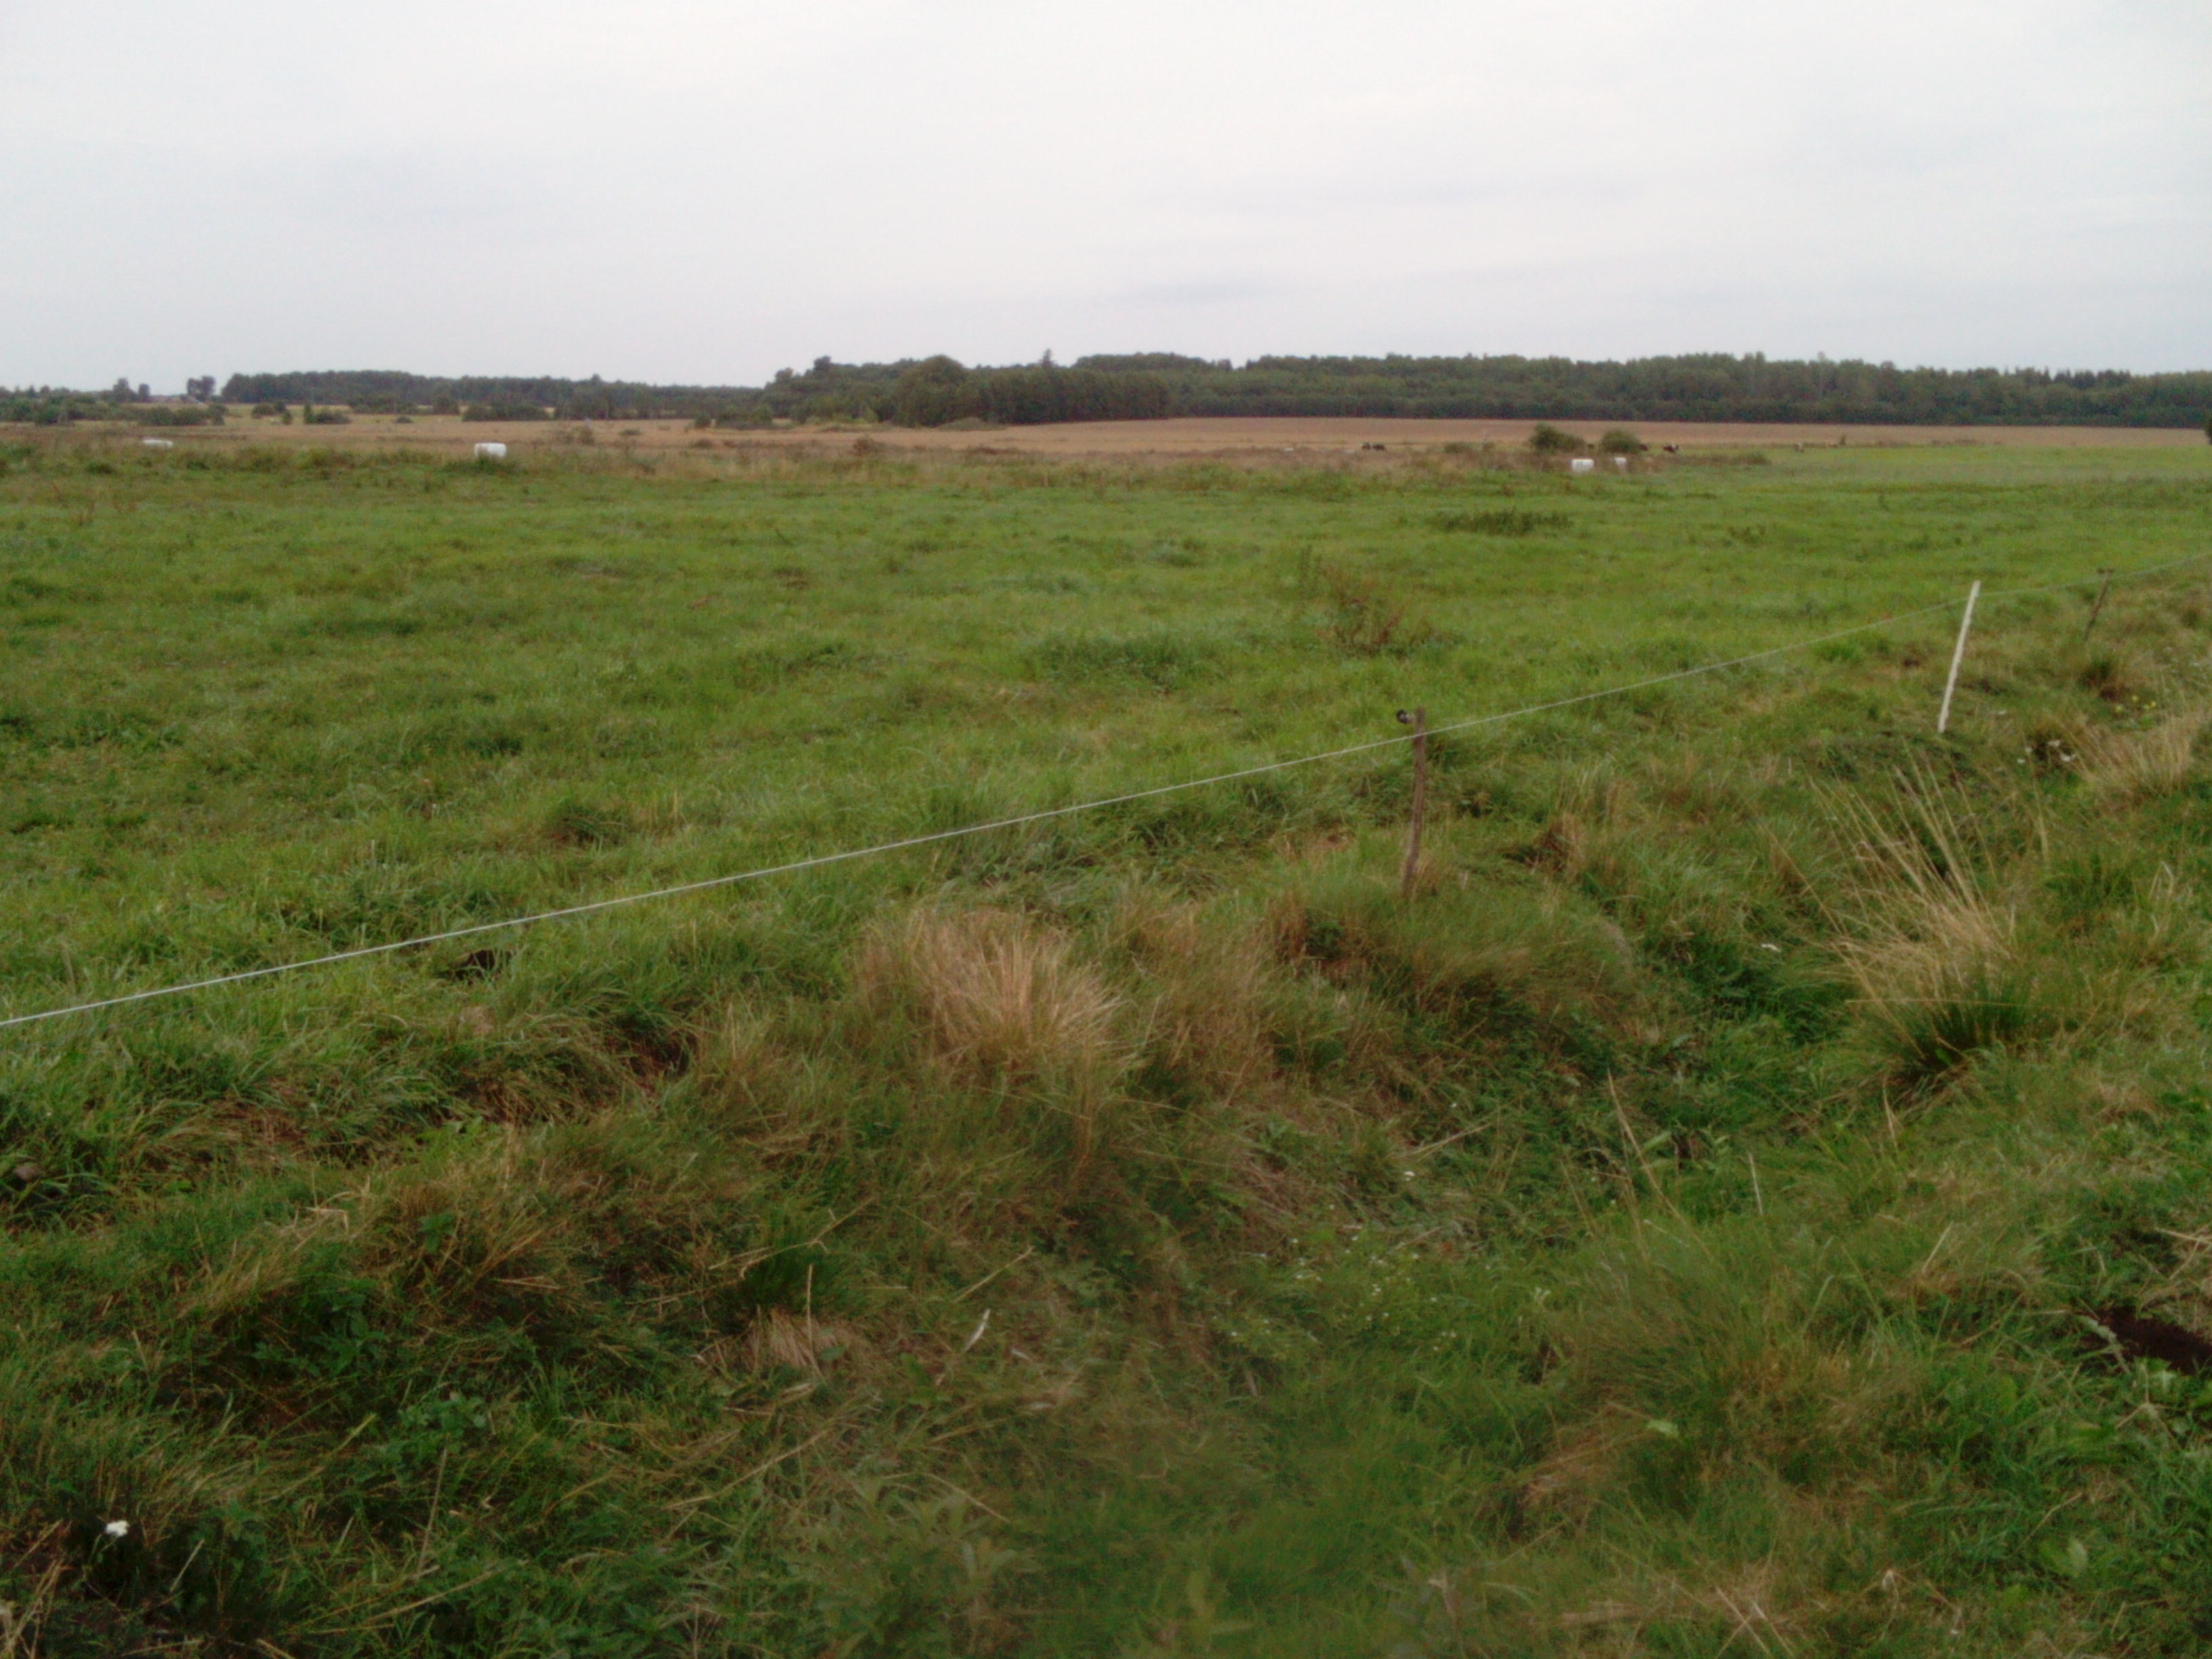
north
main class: Grassland
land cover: Grassland without tree/shrub cover
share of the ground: > 75 %
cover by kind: herbaceous plants 100 %
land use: Agriculture (excluding fallow land and kitchen gardens)
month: September
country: LT
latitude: 55.7767
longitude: 22.8360
